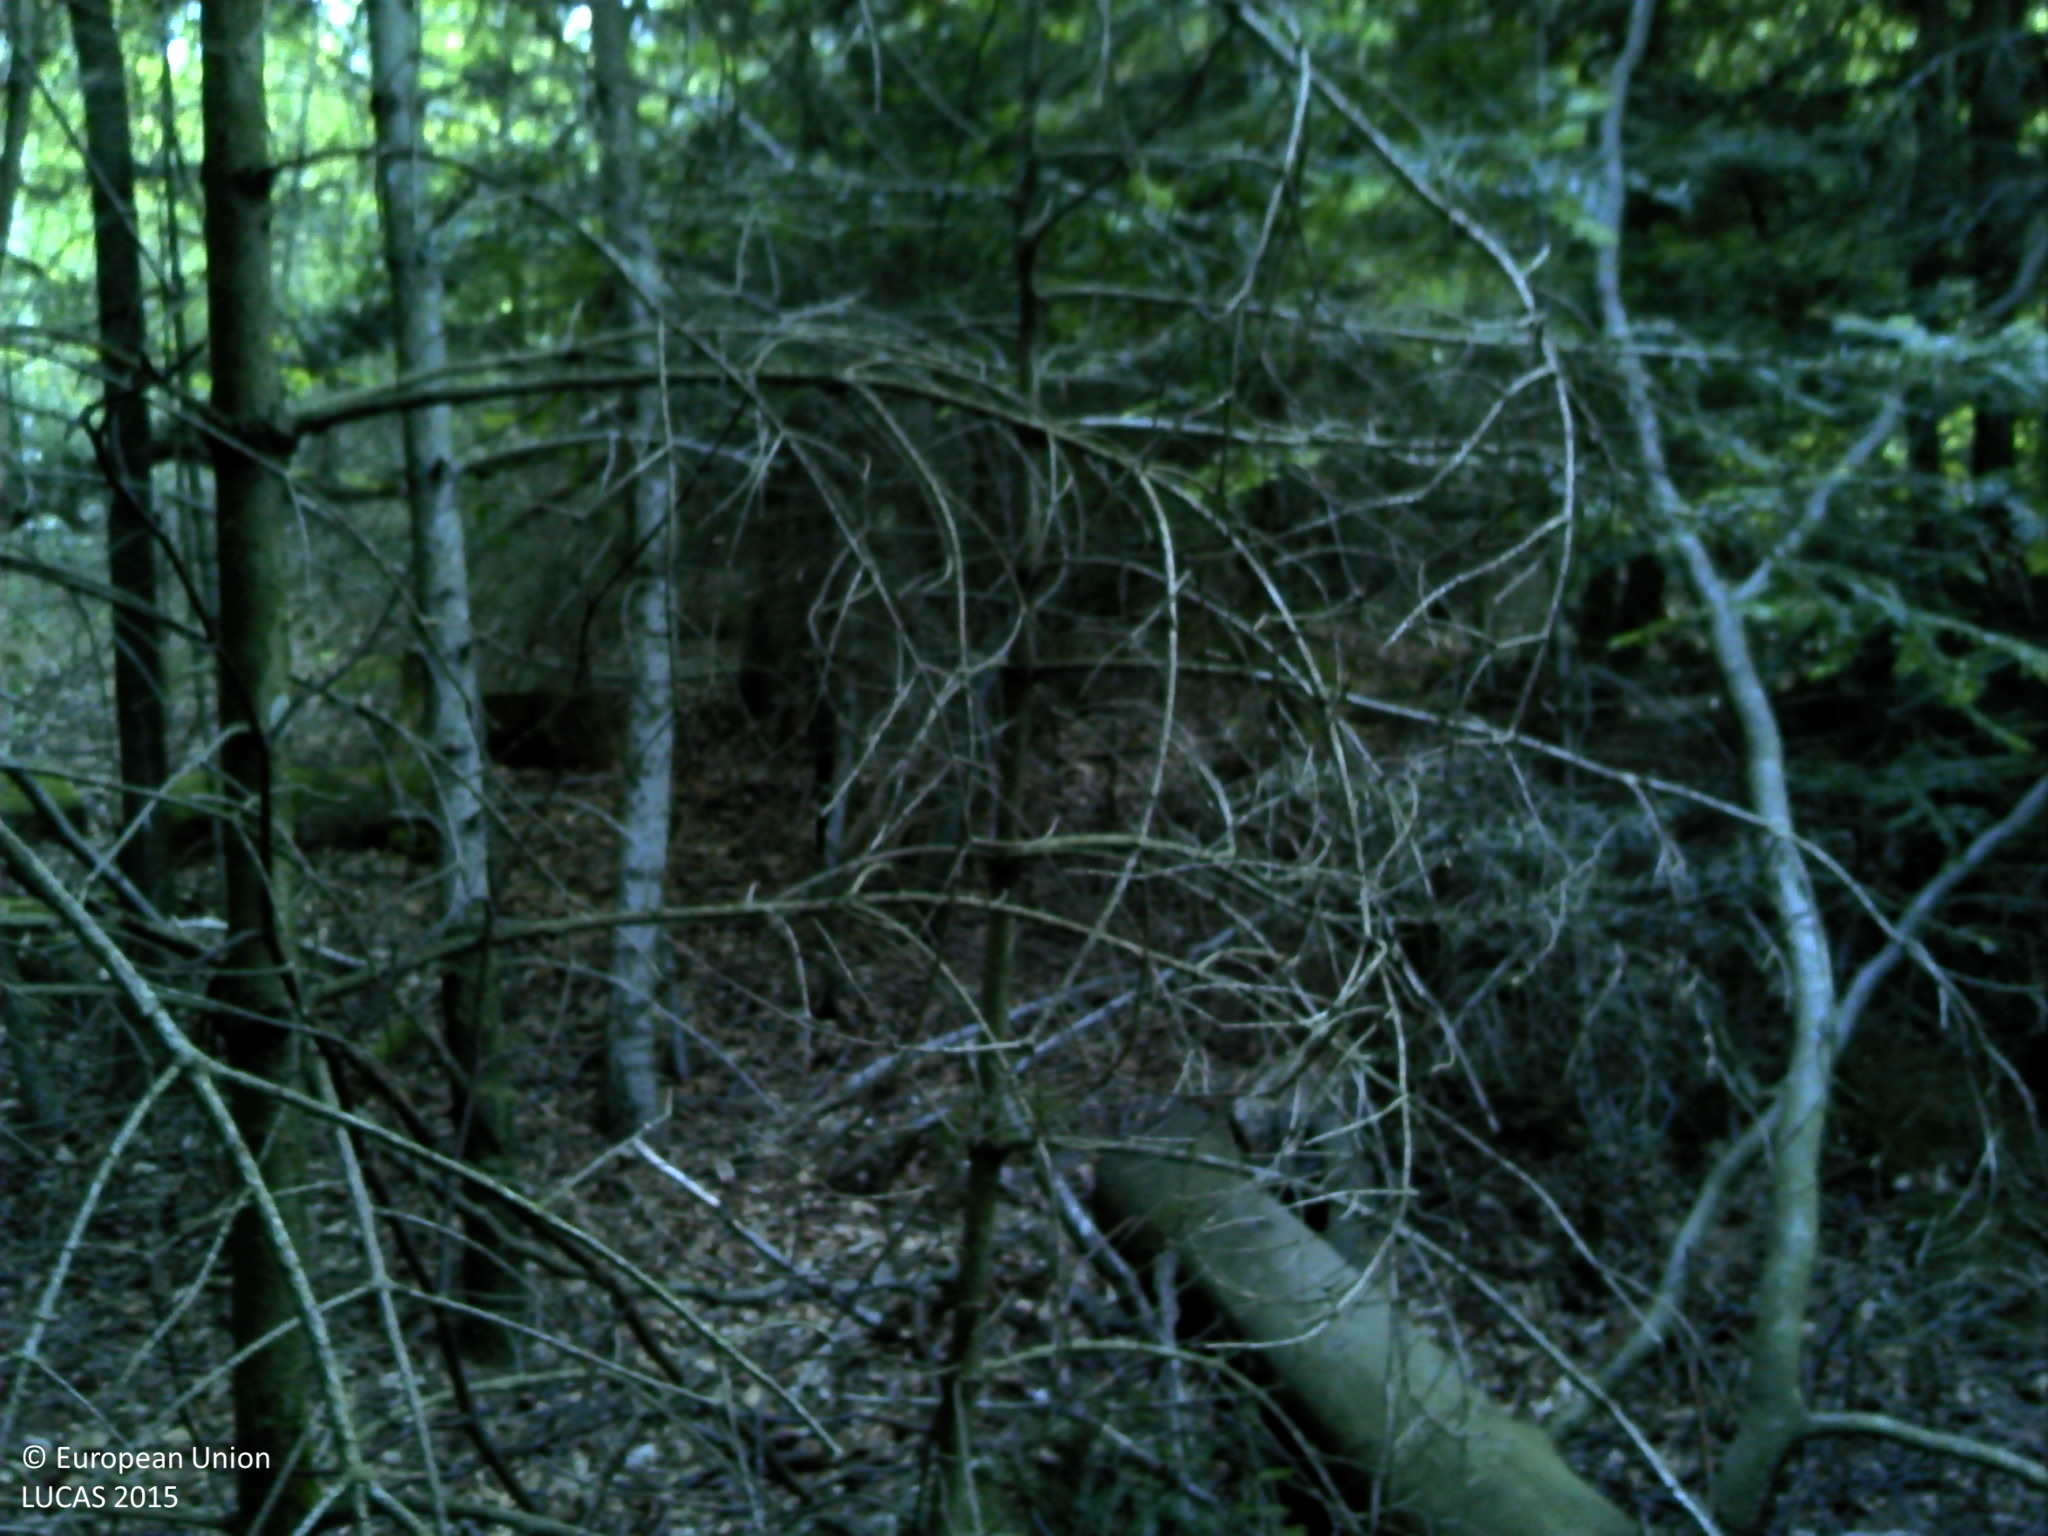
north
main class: Woodland
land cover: Spruce dominated mixed woodland
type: alpine coniferous forest
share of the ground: > 75 %
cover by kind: coniferous forest trees 60 %, broadleaved forest trees 35 %, unconsolidated bare surface 5 %
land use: Forestry
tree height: > 5 m
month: August
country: FR
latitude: 48.2869
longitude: 6.8606
